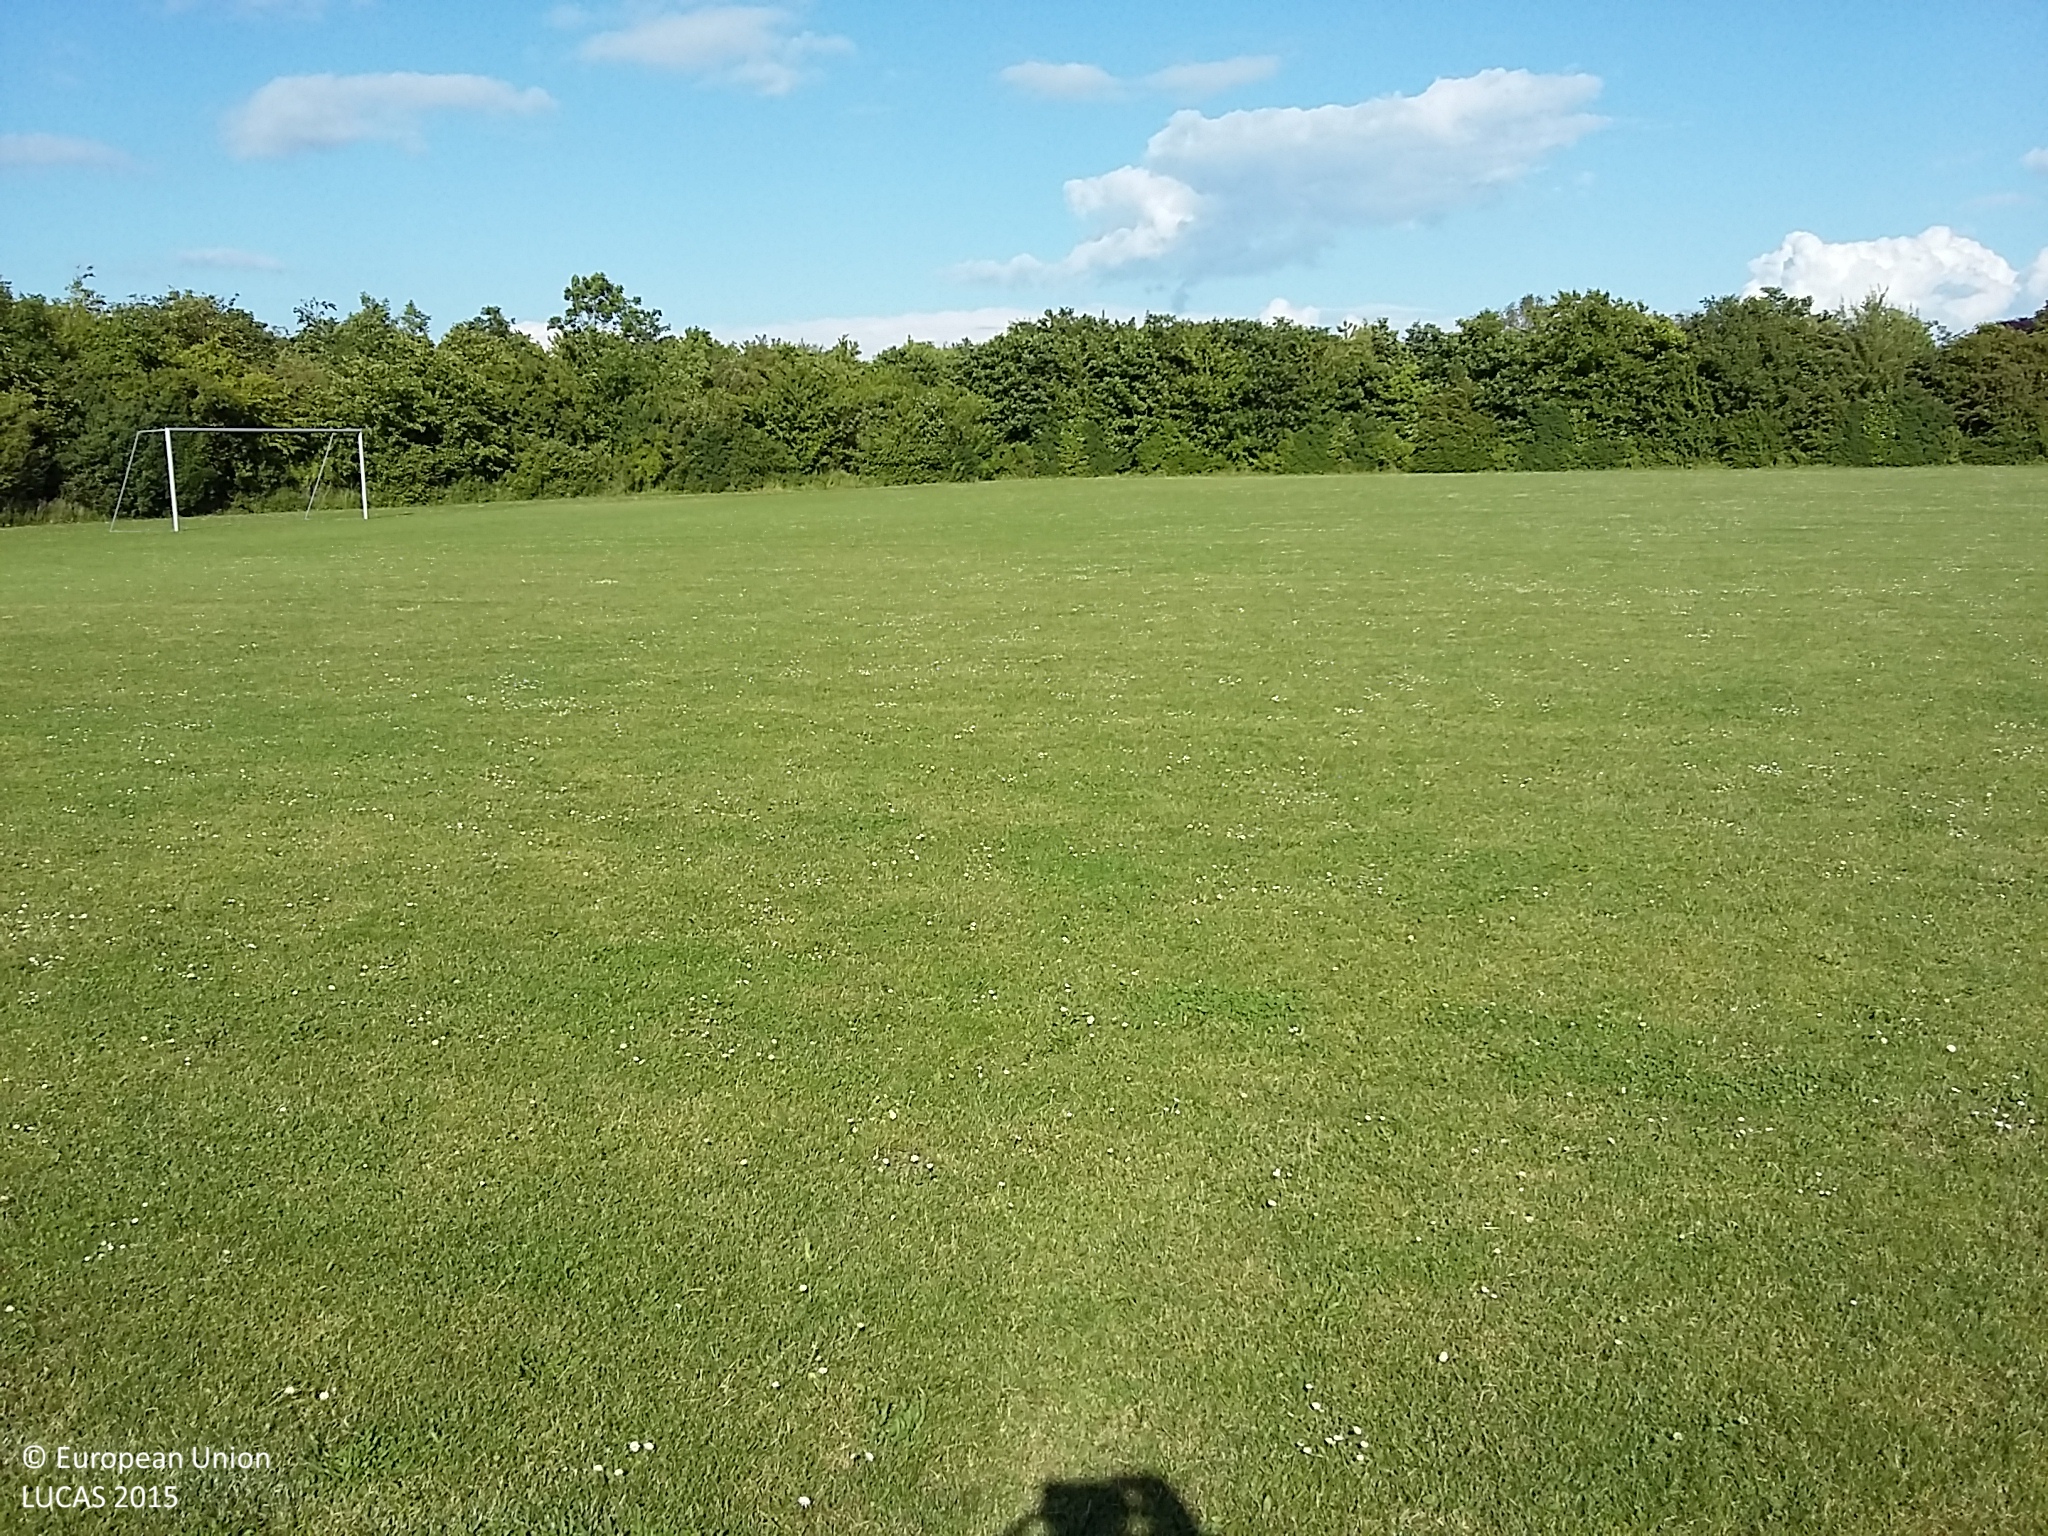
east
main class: Grassland
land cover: Grassland without tree/shrub cover
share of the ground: > 75 %
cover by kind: herbaceous plants 100 %
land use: Sport
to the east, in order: Grassland without tree/shrub cover; Broadleaved woodland; Grass margins; Paved roads, cycling and walking lanes; Grass margins; Common wheat
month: June
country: DK
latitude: 54.7627
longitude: 11.1337
